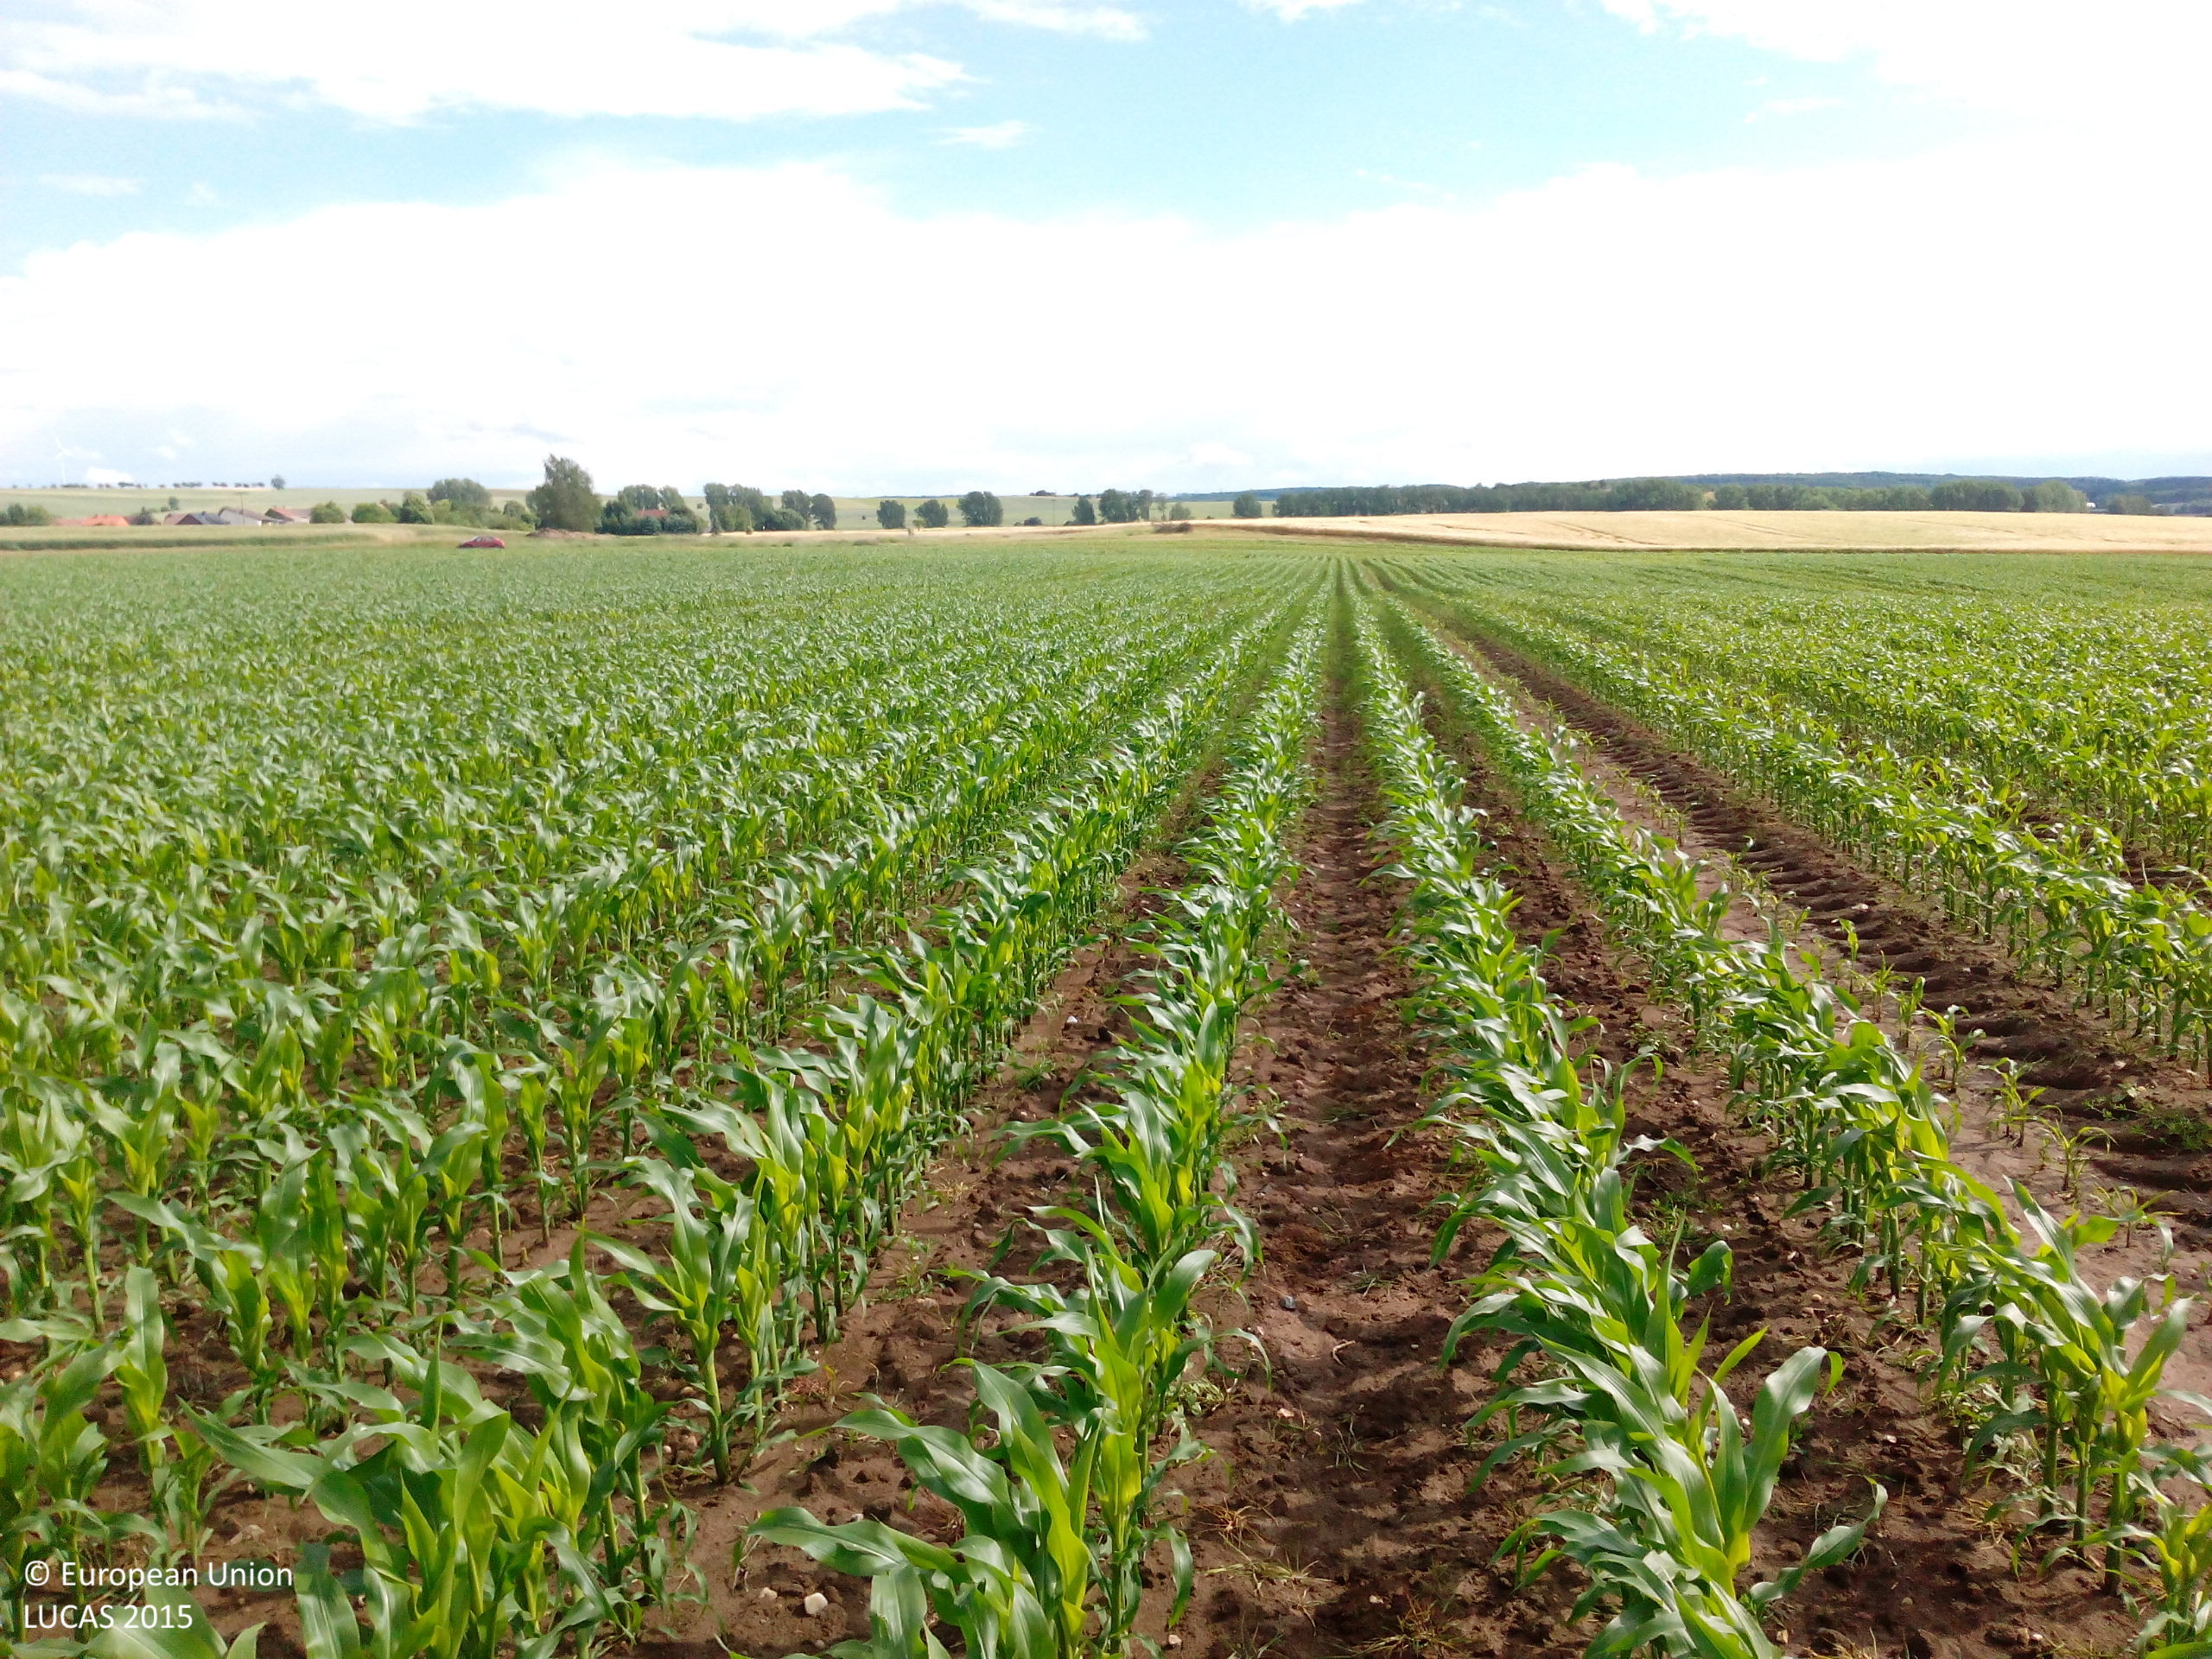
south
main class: Cropland
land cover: Maize
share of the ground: 10 - 25 %
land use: Agriculture (excluding fallow land and kitchen gardens)
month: June
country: DE
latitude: 52.2463
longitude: 11.1274
